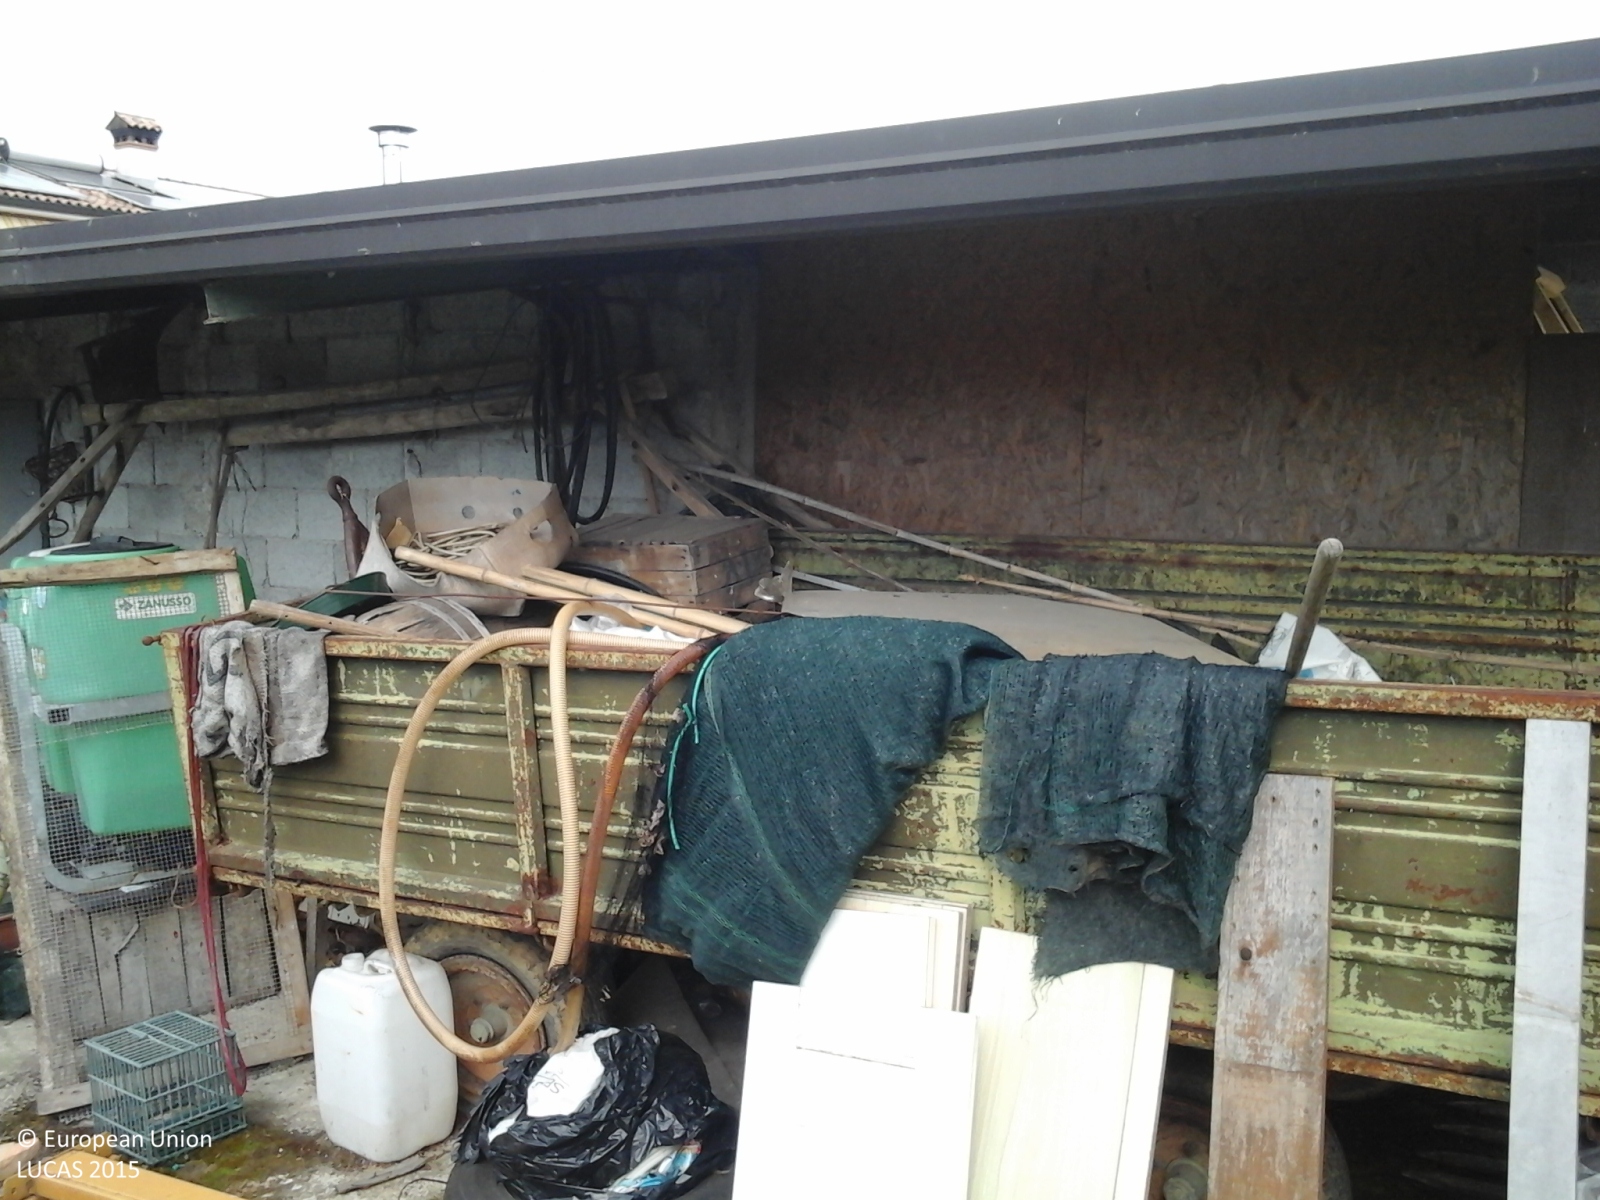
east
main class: Grassland
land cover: Grassland without tree/shrub cover
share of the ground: > 75 %
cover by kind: herbaceous plants 100 %
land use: Residential
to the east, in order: Grassland without tree/shrub cover; Artificial constructions in urban areas; Lines of trees; Grassland without tree/shrub cover; Electric lines; Abandoned hedges; Ditches and canals; Paved roads, cycling and walking lanes; Ditches and canals; Abandoned hedges; Electric lines; Grassland without tree/shrub cover; Lines of trees; Grassland without tree/shrub cover; Ditches and canals; Soya; Ditches and canals; Soya
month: June
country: IT
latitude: 45.8556
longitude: 12.4051
